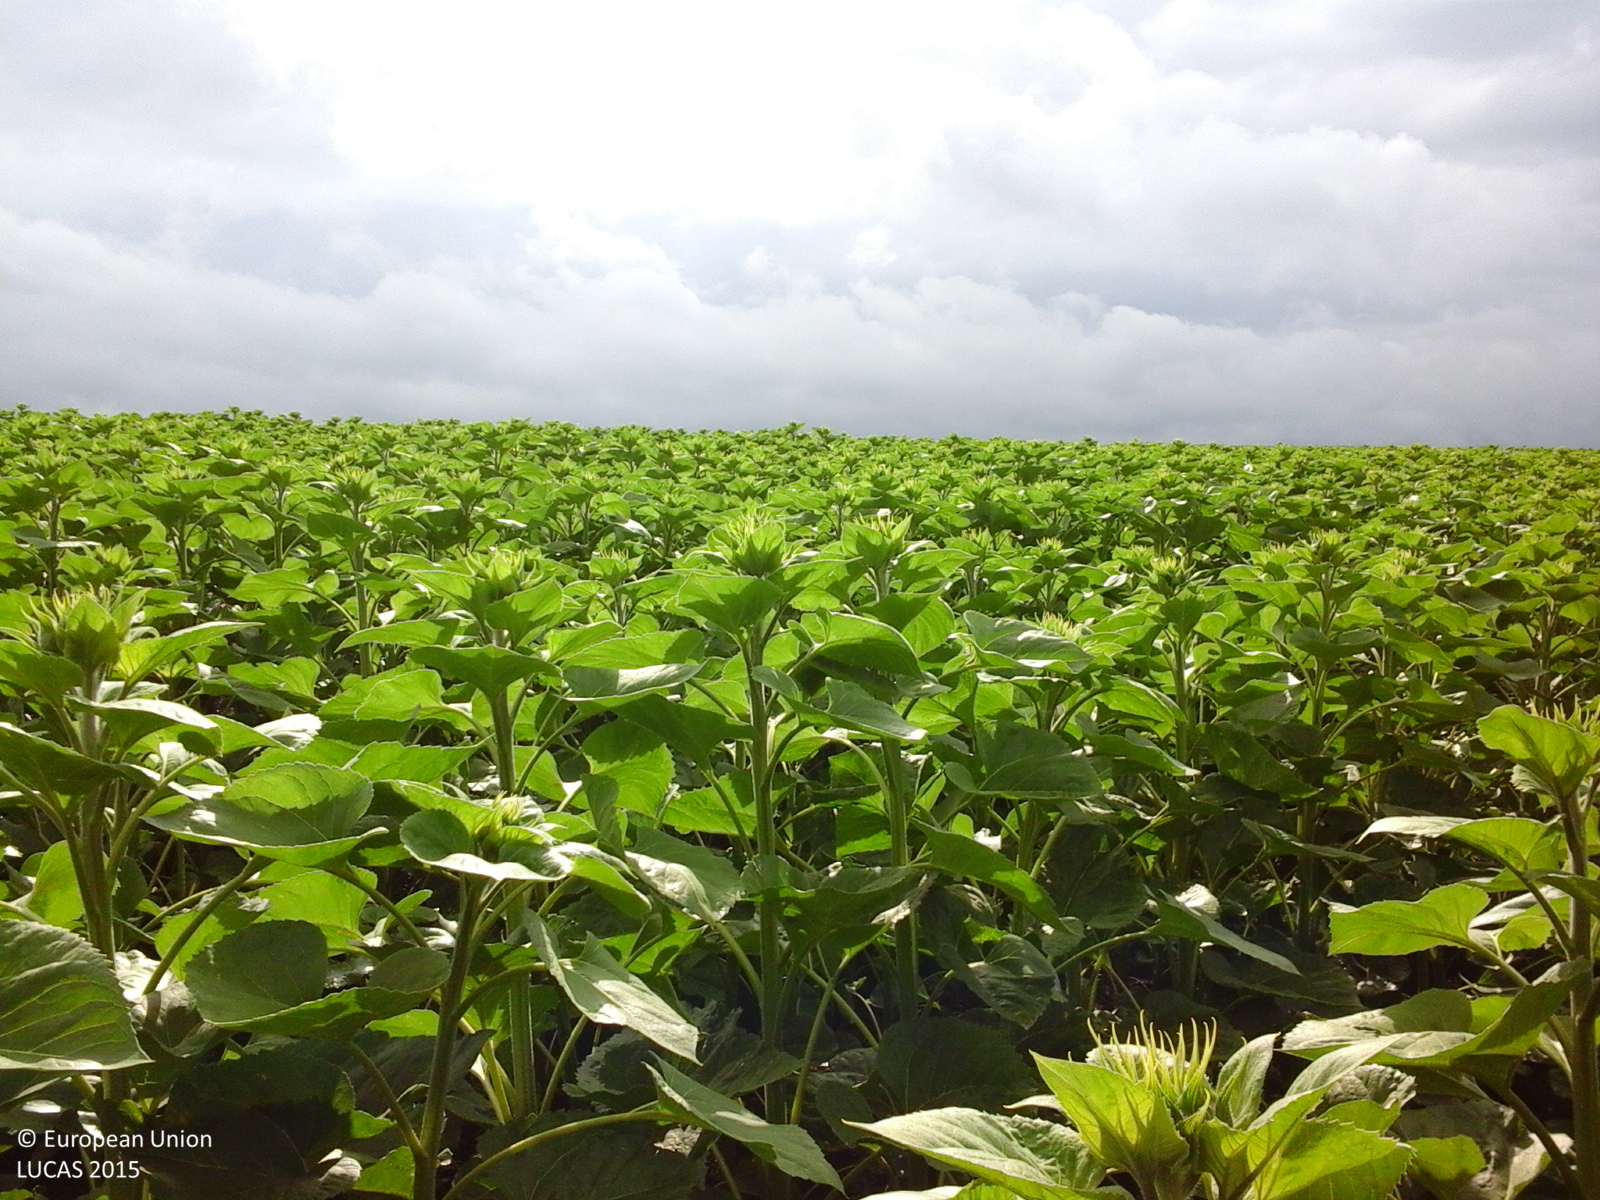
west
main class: Cropland
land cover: Sunflower
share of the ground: > 75 %
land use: Agriculture (excluding fallow land and kitchen gardens)
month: June
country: RO
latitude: 47.9902
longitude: 26.4246
